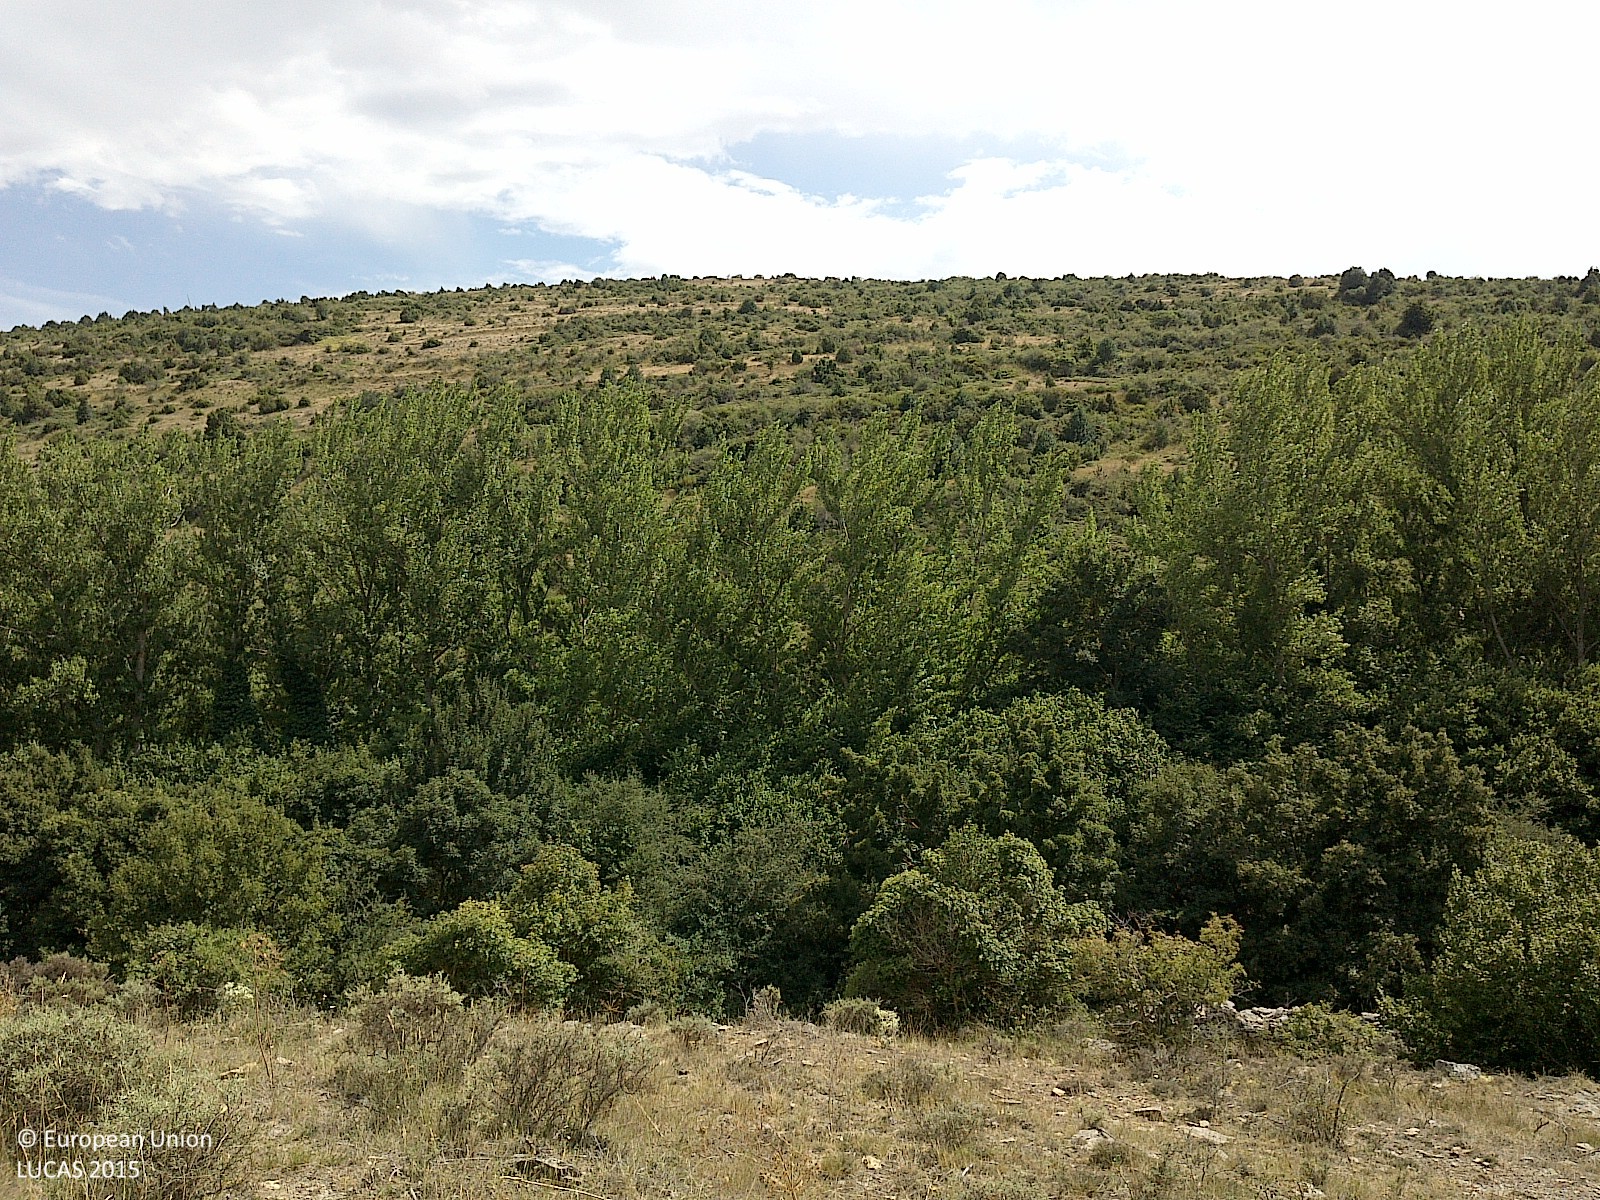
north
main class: Shrubland
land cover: Shrubland with sparse tree cover
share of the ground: 50 - 75 %
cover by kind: shrubs 60 %, herbaceous plants 35 %, broadleaved forest trees 5 %
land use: Semi-natural and natural areas not in use
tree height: < 5 m
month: July
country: ES
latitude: 41.9758
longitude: -2.2873
